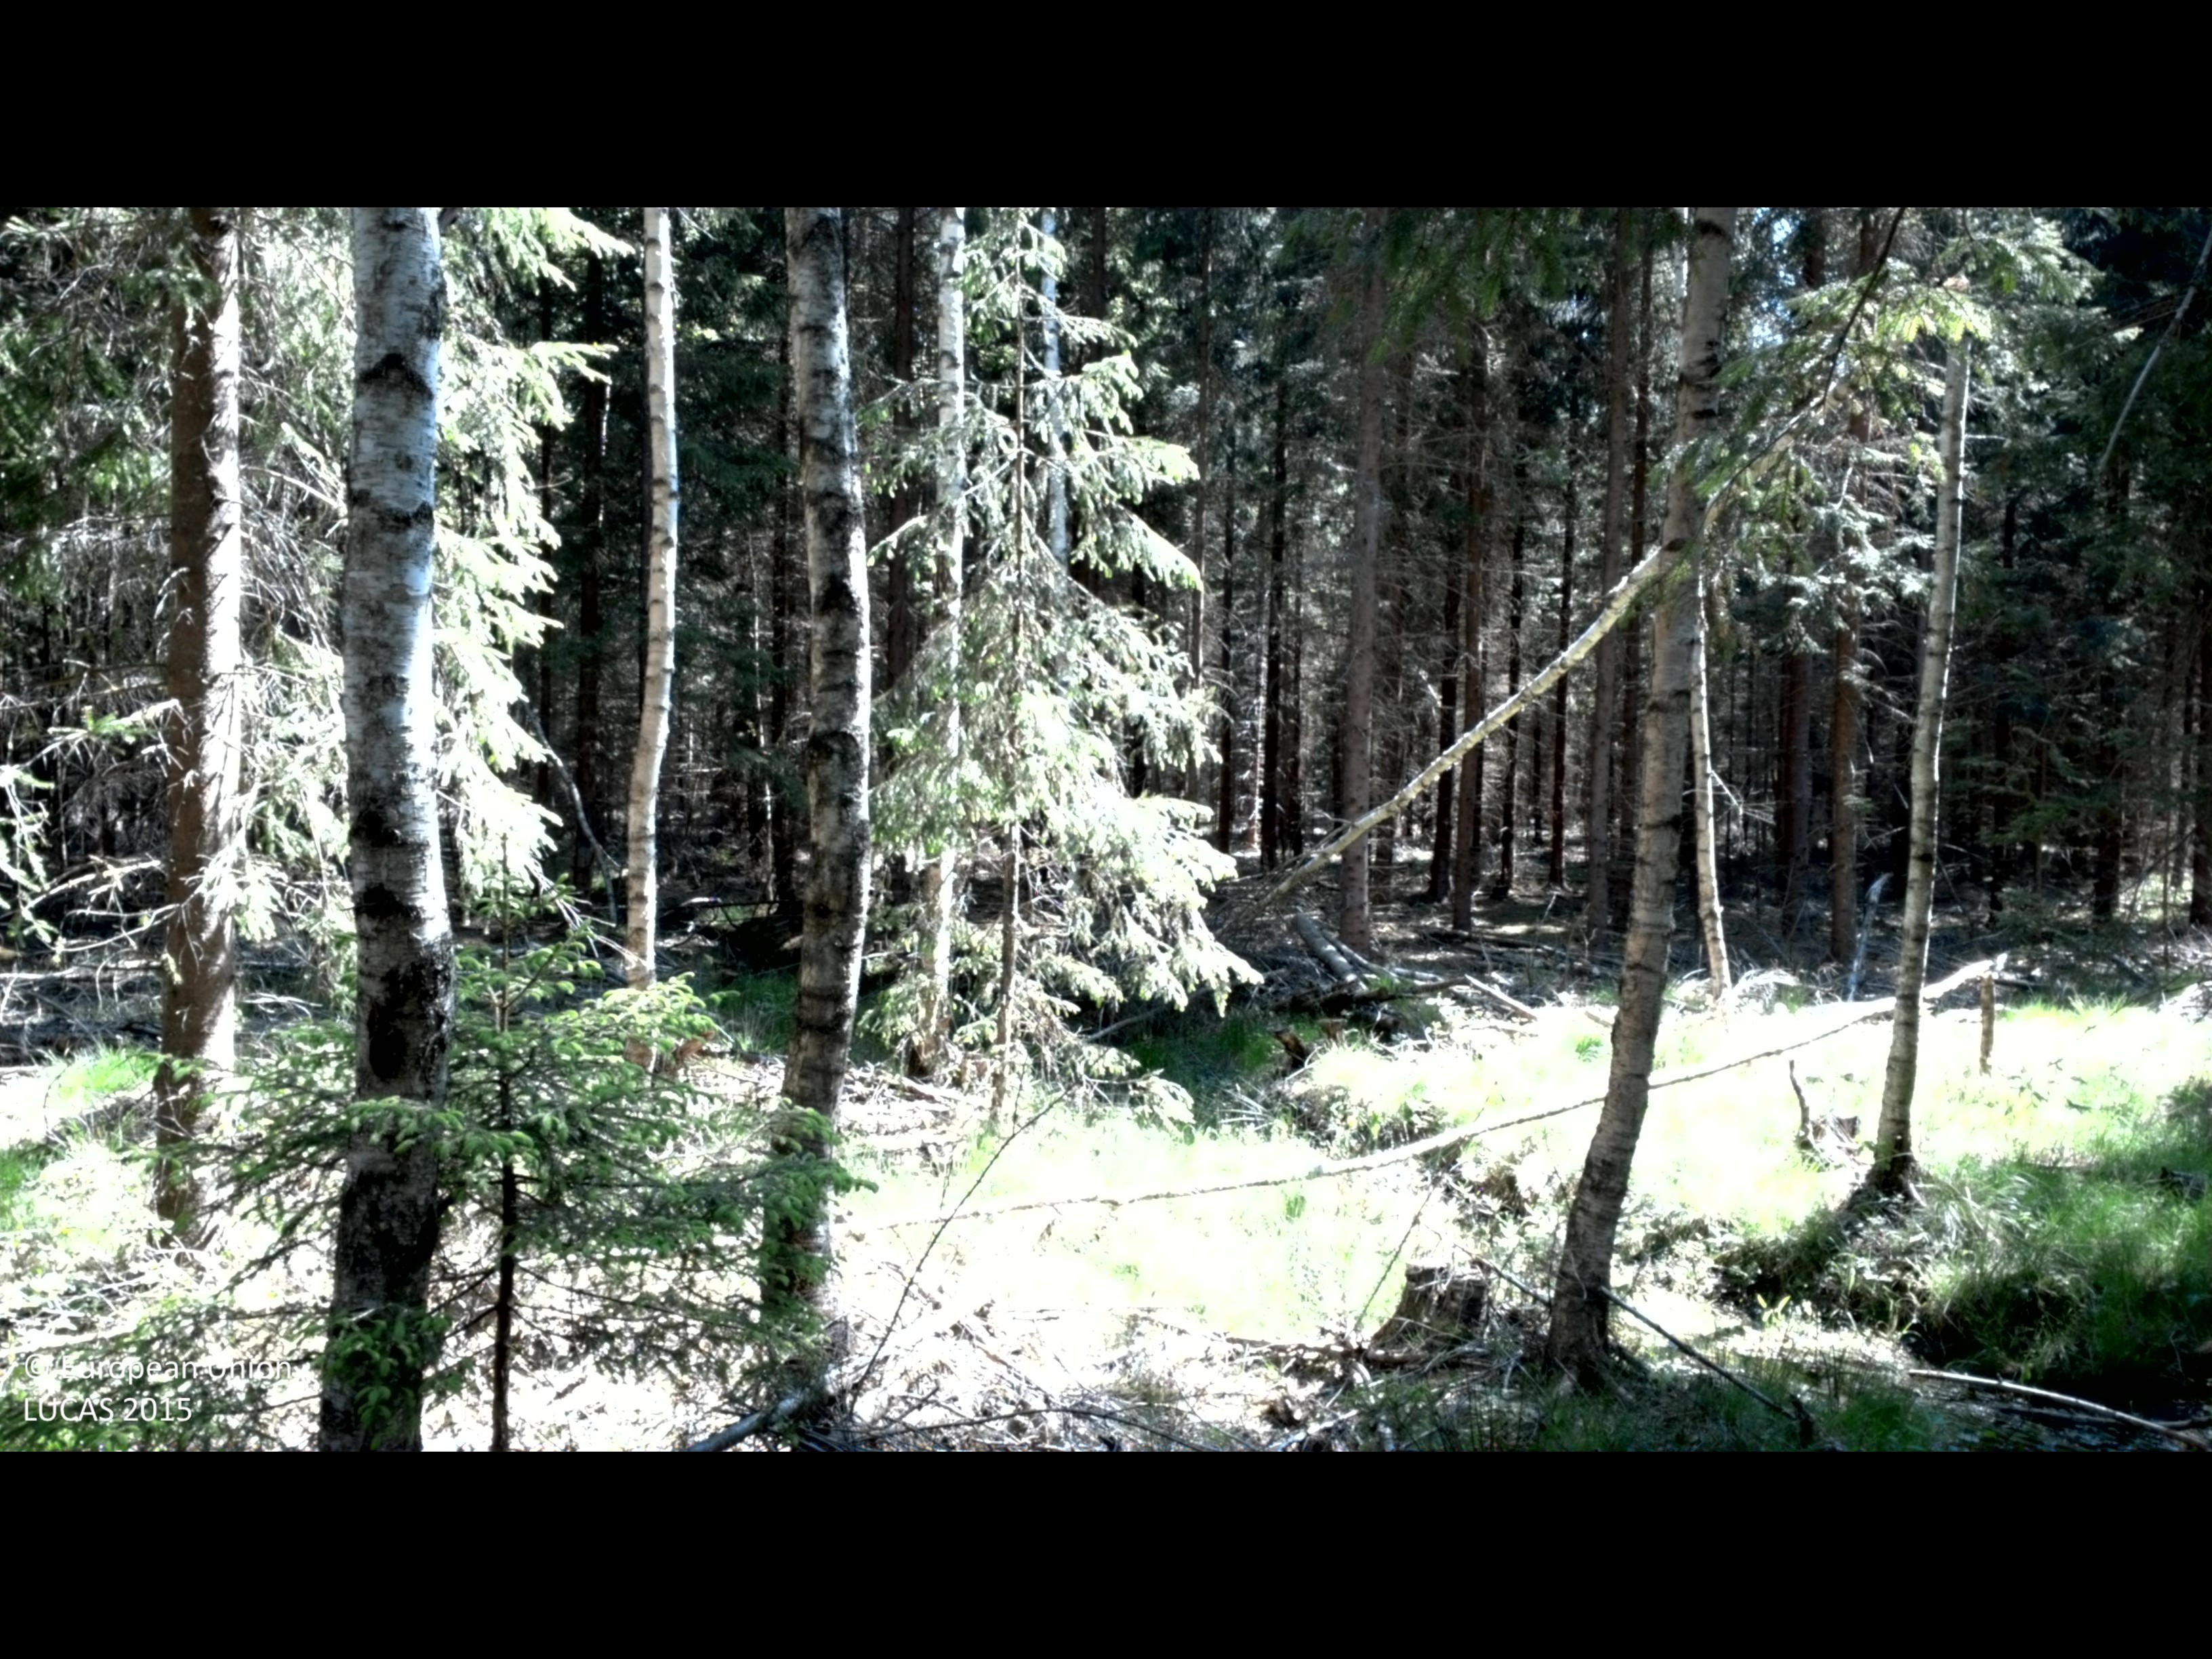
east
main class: Woodland
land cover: Spruce dominated coniferous woodland
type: boreal forest
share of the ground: 50 - 75 %
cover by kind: coniferous forest trees 55 %, herbaceous plants 25 %, broadleaved forest trees 10 %, unconsolidated bare surface 5 %
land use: Forestry
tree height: > 5 m
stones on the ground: < 10 %
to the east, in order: Spruce dominated coniferous woodland; Ditches and canals; Spruce dominated coniferous woodland; Ditches and canals; Spruce dominated coniferous woodland; Spruce dominated mixed woodland; Spruce dominated coniferous woodland
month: June
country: SE
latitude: 57.7518
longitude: 16.1980
